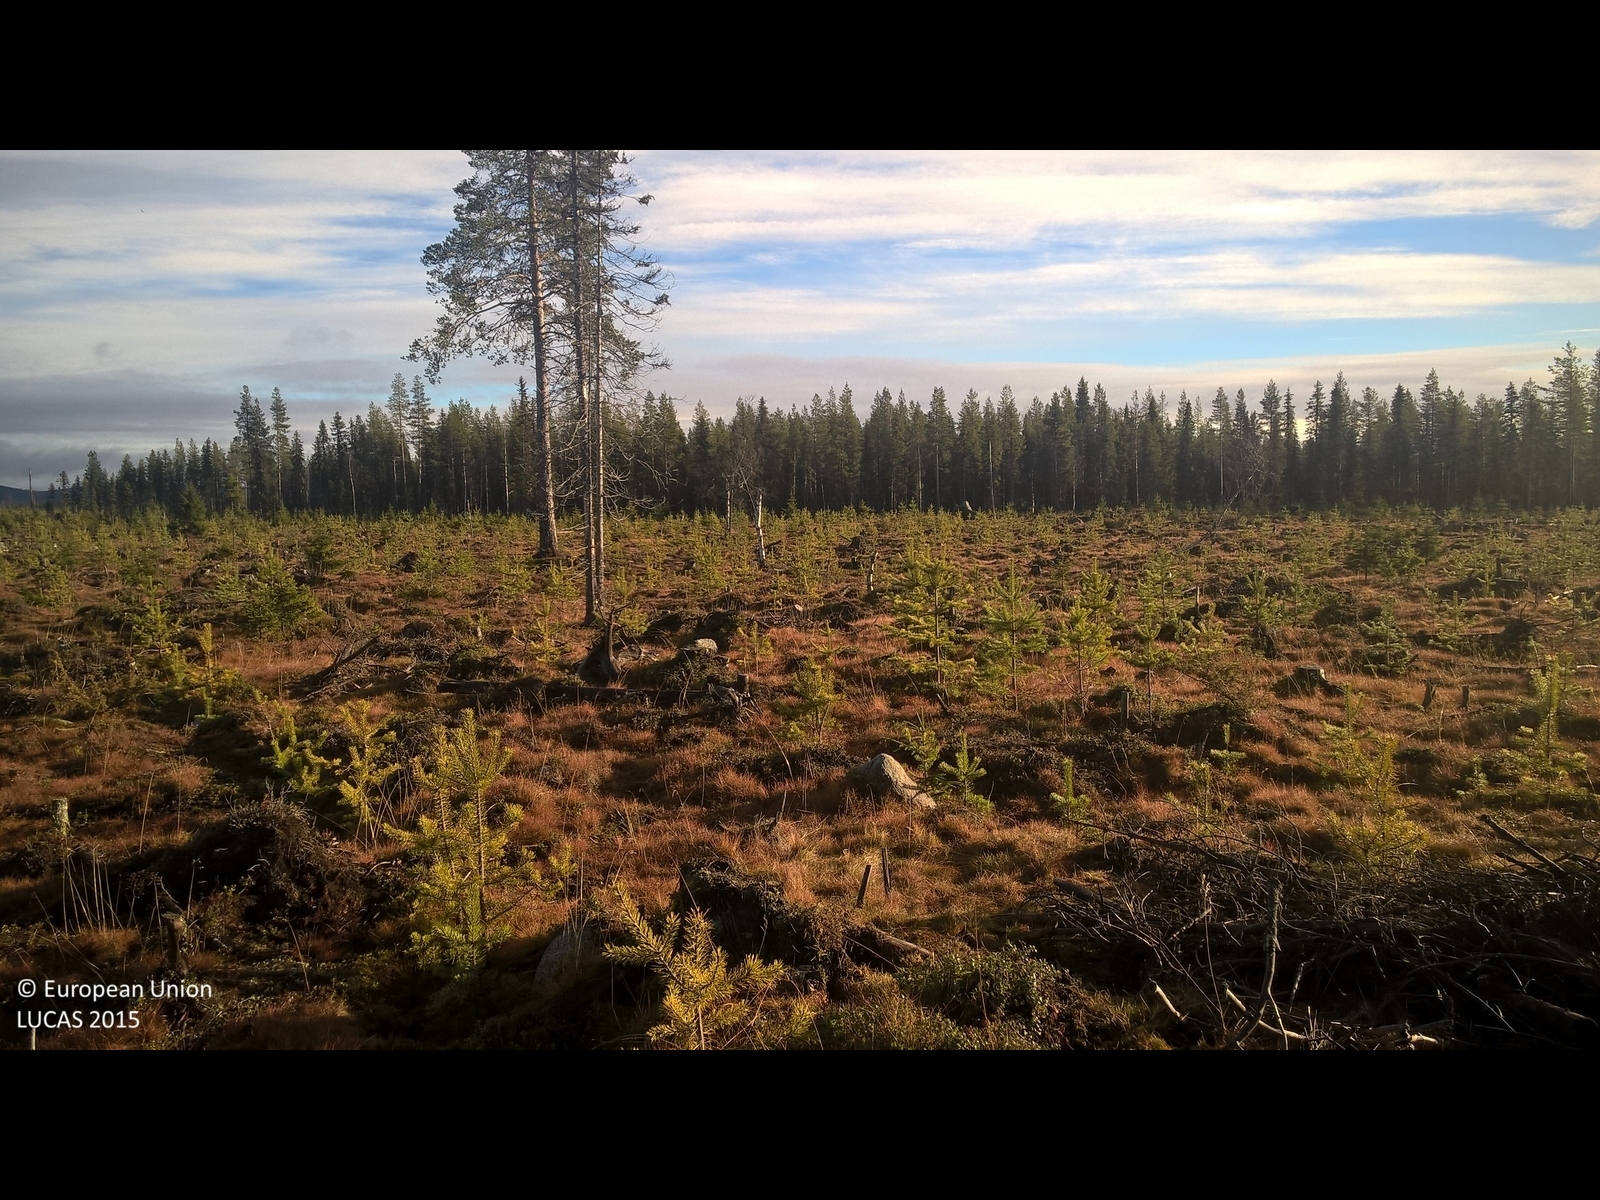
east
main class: Woodland
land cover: Pine dominated coniferous woodland
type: boreal forest
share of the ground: 50 - 75 %
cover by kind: coniferous forest trees 50 %, shrubs 25 %, herbaceous plants 25 %
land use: Forestry
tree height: < 5 m
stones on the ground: < 10 %
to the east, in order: Pine dominated coniferous woodland; Spruce dominated coniferous woodland
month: October
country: SE
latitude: 65.3595
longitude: 18.7104
